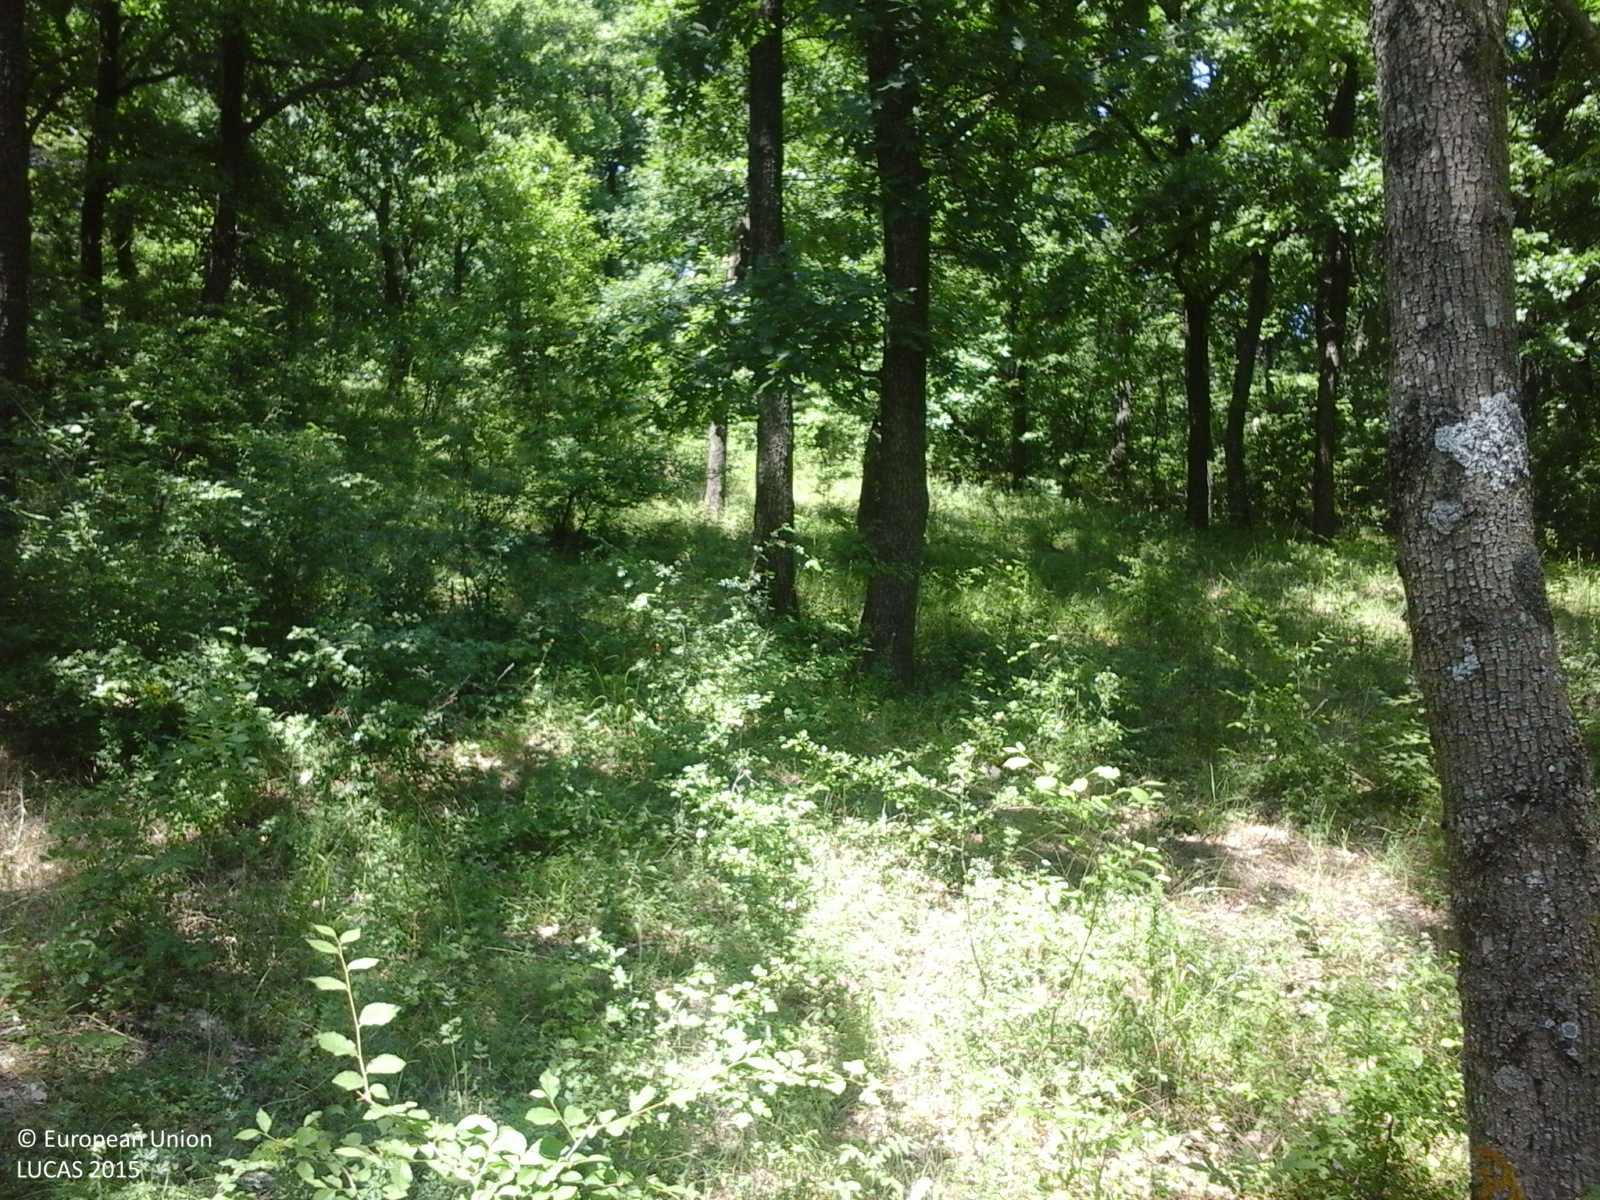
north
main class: Woodland
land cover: Broadleaved woodland
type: beech forest
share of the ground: > 75 %
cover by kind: broadleaved forest trees 100 %
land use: Forestry
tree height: > 5 m
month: June
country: RO
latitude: 46.8097
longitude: 27.9363
